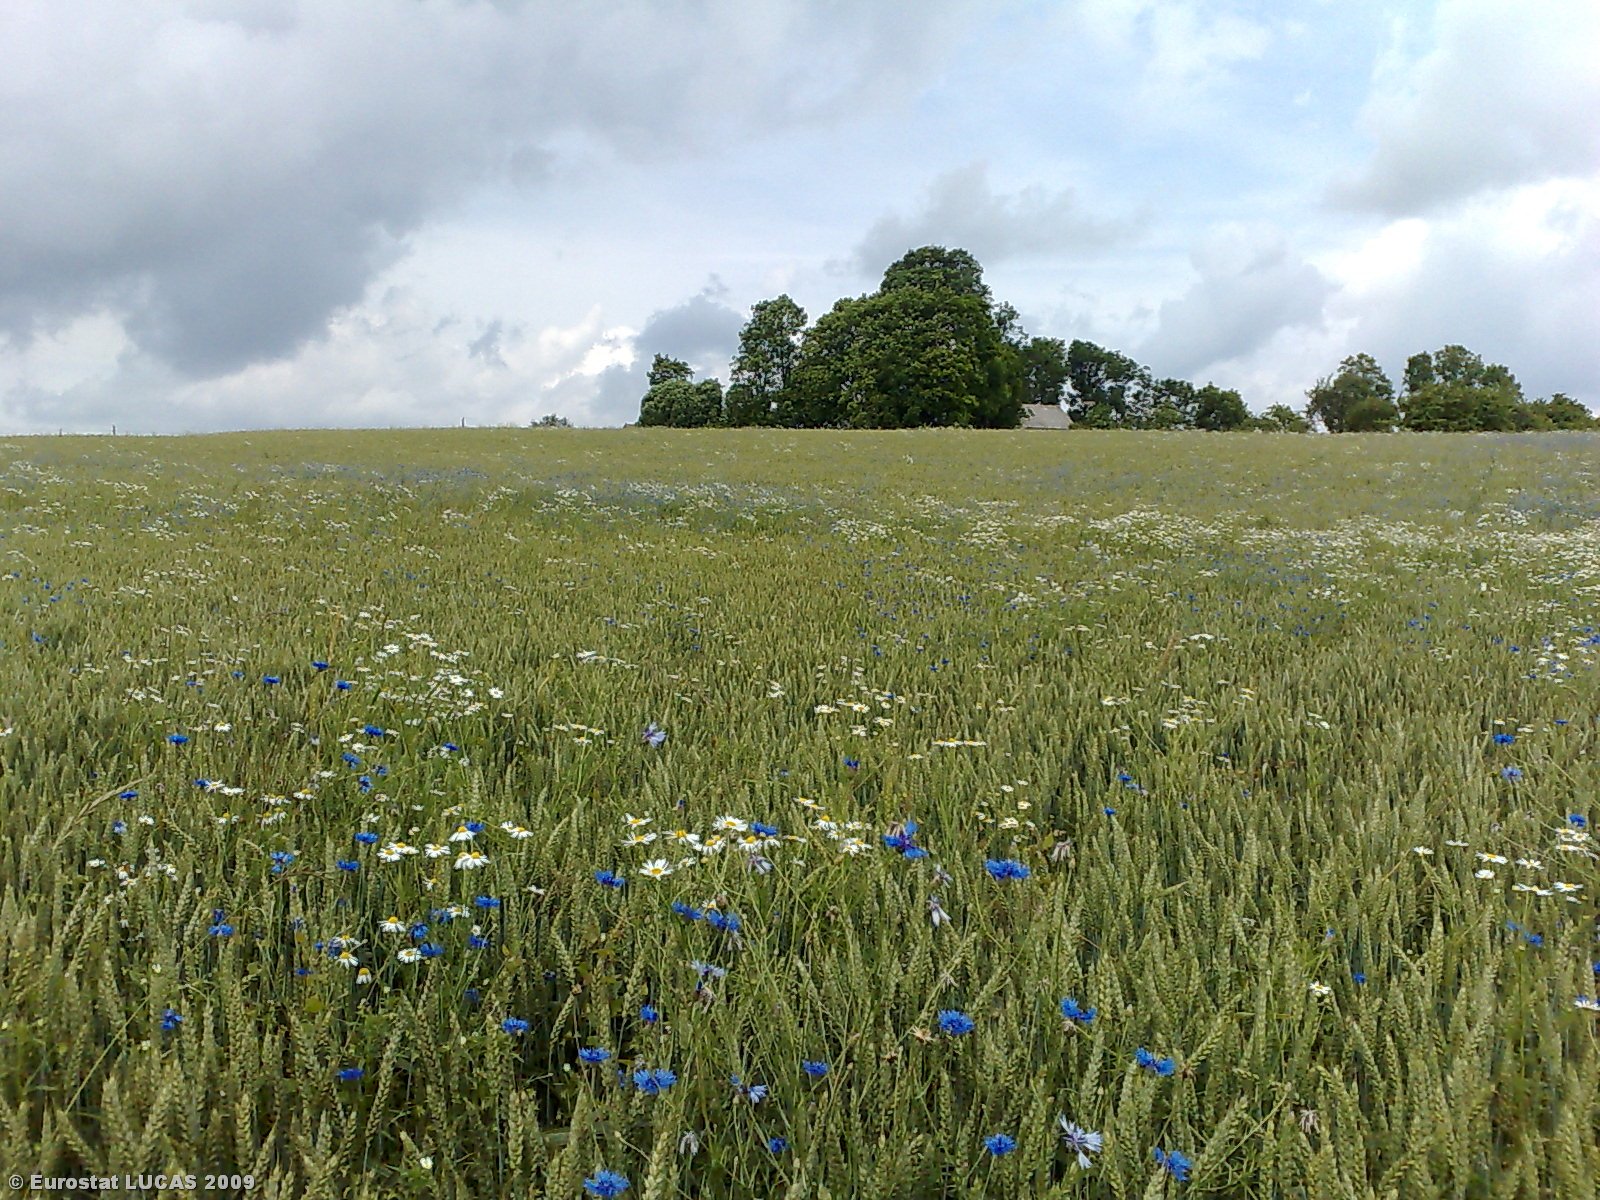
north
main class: Cropland
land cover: Common wheat
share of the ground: > 75 %
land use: Agriculture (excluding fallow land and kitchen gardens)
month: July
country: LT
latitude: 55.6179
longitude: 22.7839
